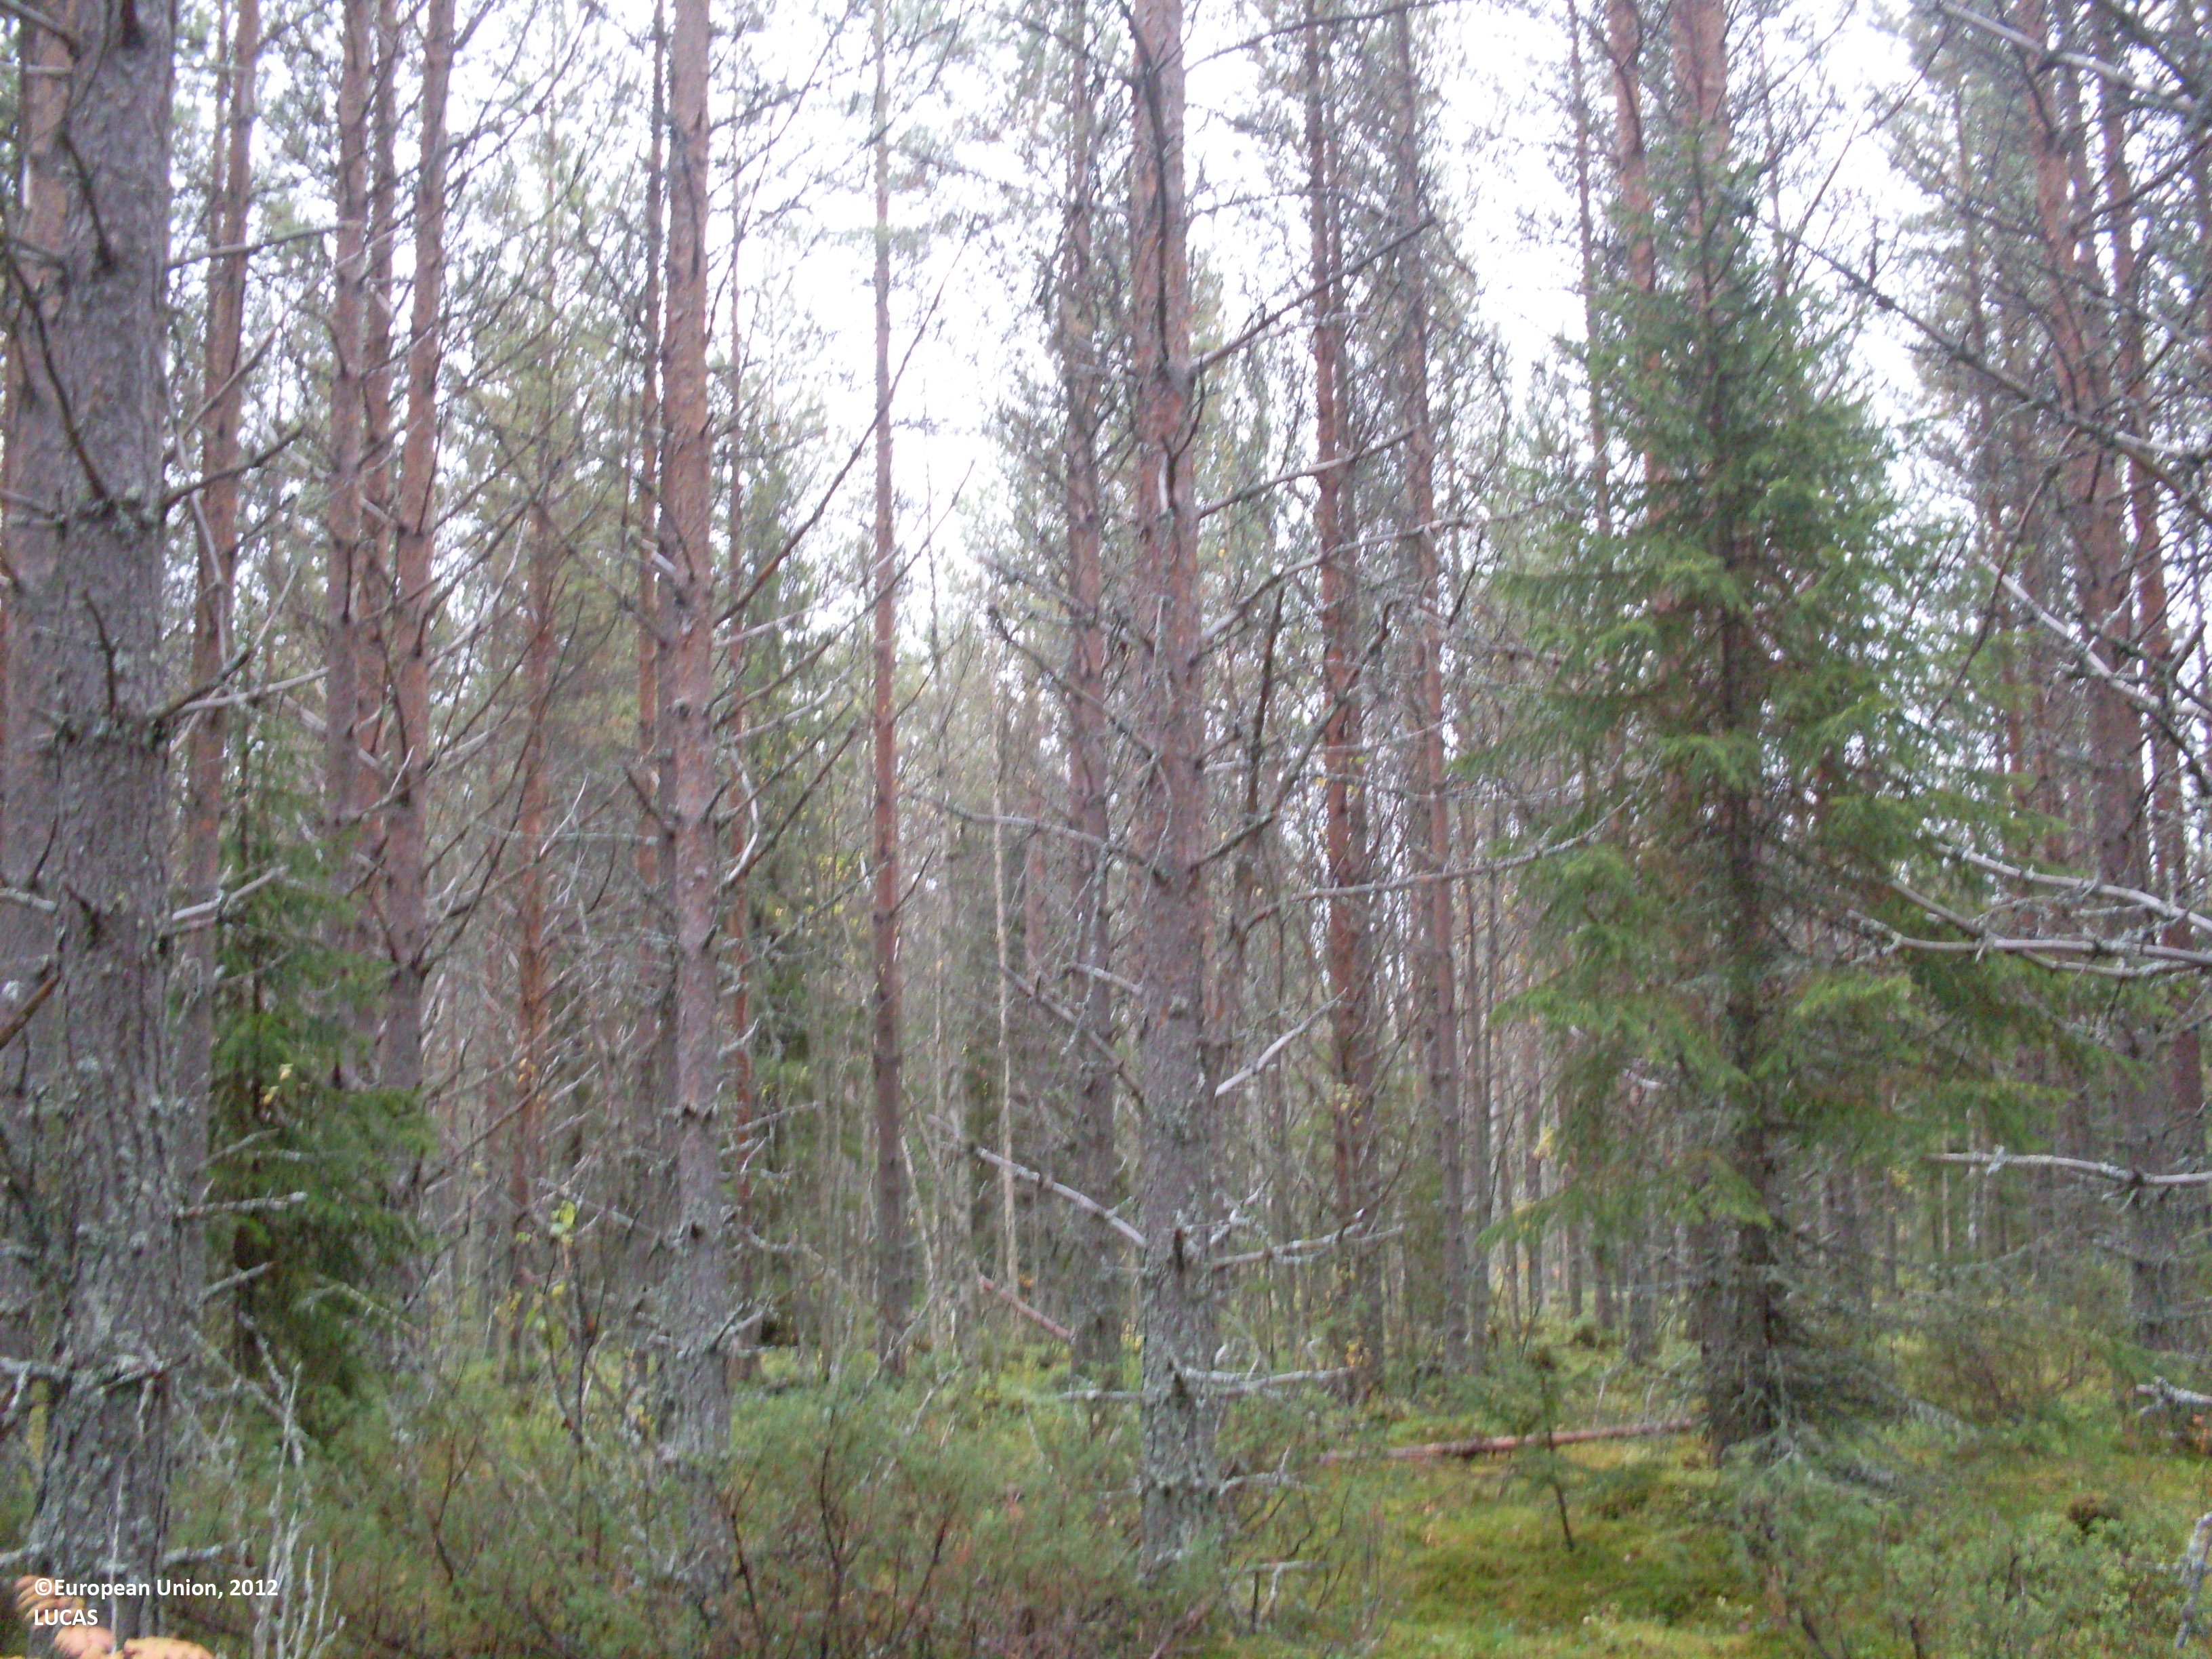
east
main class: Woodland
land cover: Pine dominated mixed woodland
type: boreal forest
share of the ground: 50 - 75 %
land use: Forestry
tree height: > 5 m
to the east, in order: Pine dominated mixed woodland; Ditches and canals; Pine dominated mixed woodland; Ditches and canals; Pine dominated mixed woodland
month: September
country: FI
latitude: 64.5670
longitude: 28.4769
